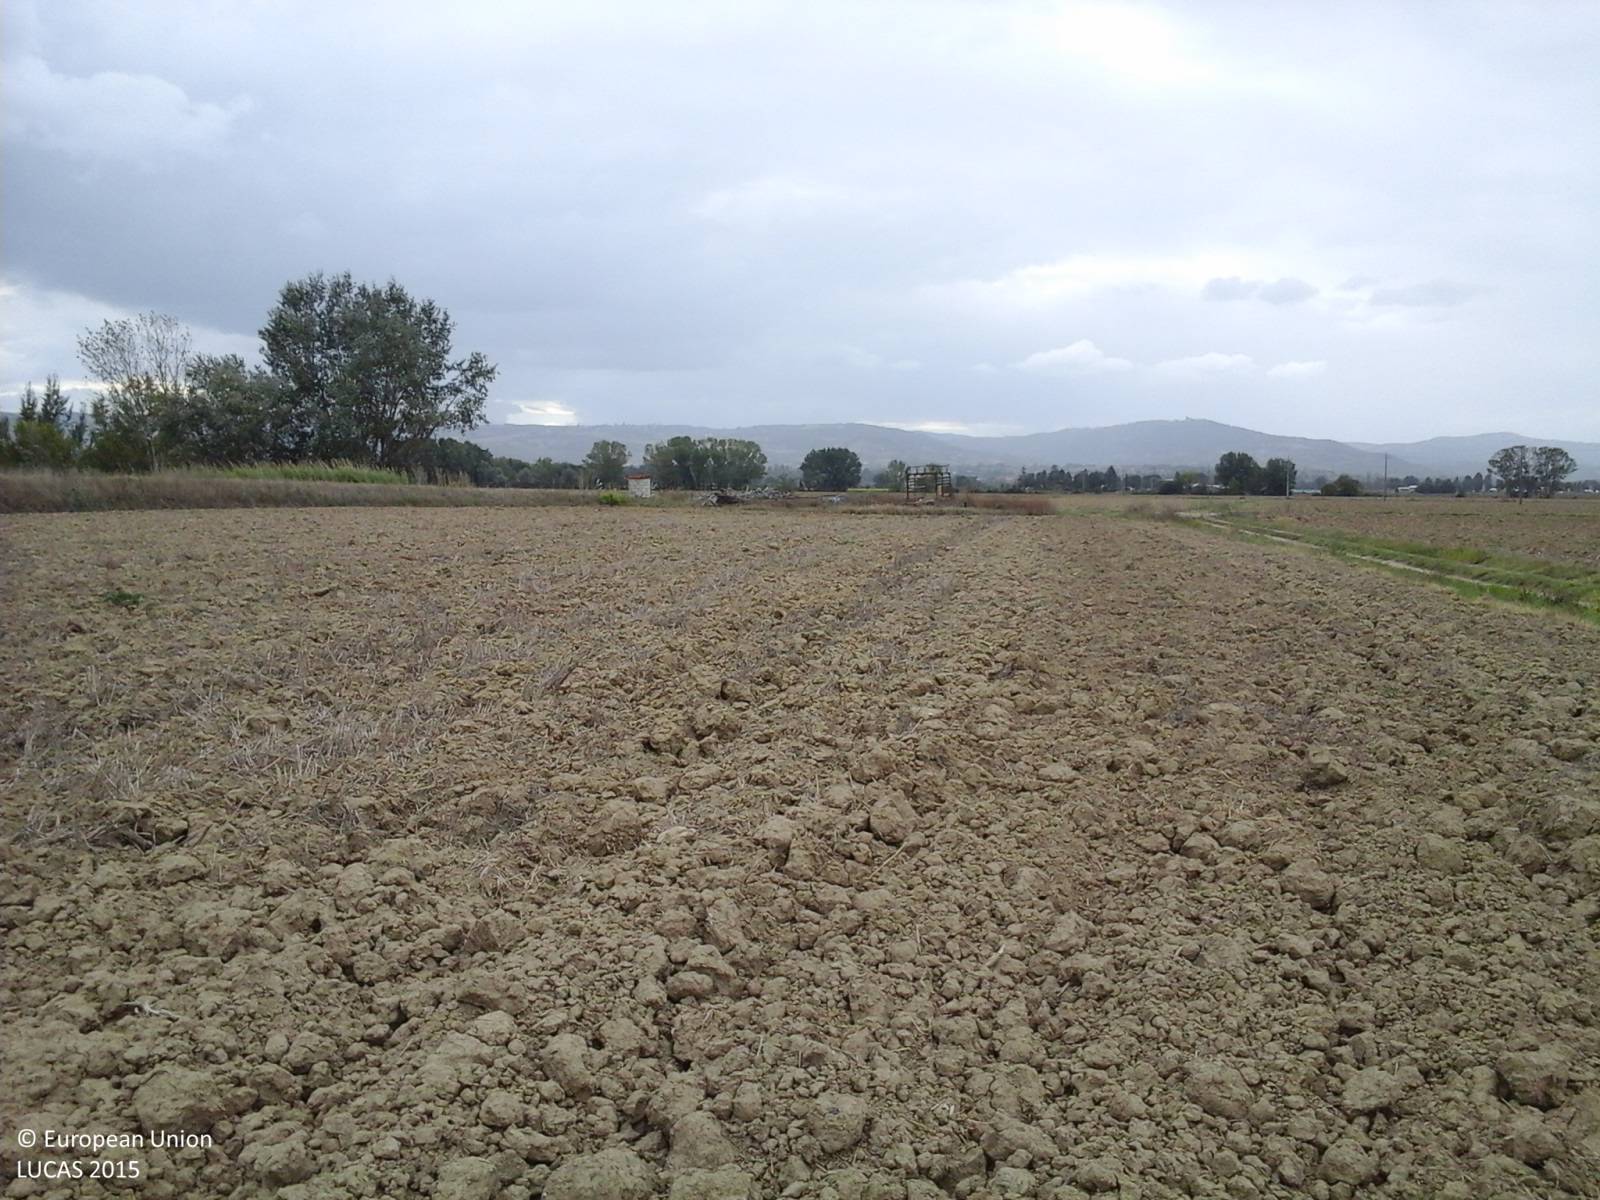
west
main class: Cropland
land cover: Sunflower
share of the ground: < 10 %
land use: Agriculture (excluding fallow land and kitchen gardens)
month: September
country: IT
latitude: 42.9151
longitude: 12.3815
